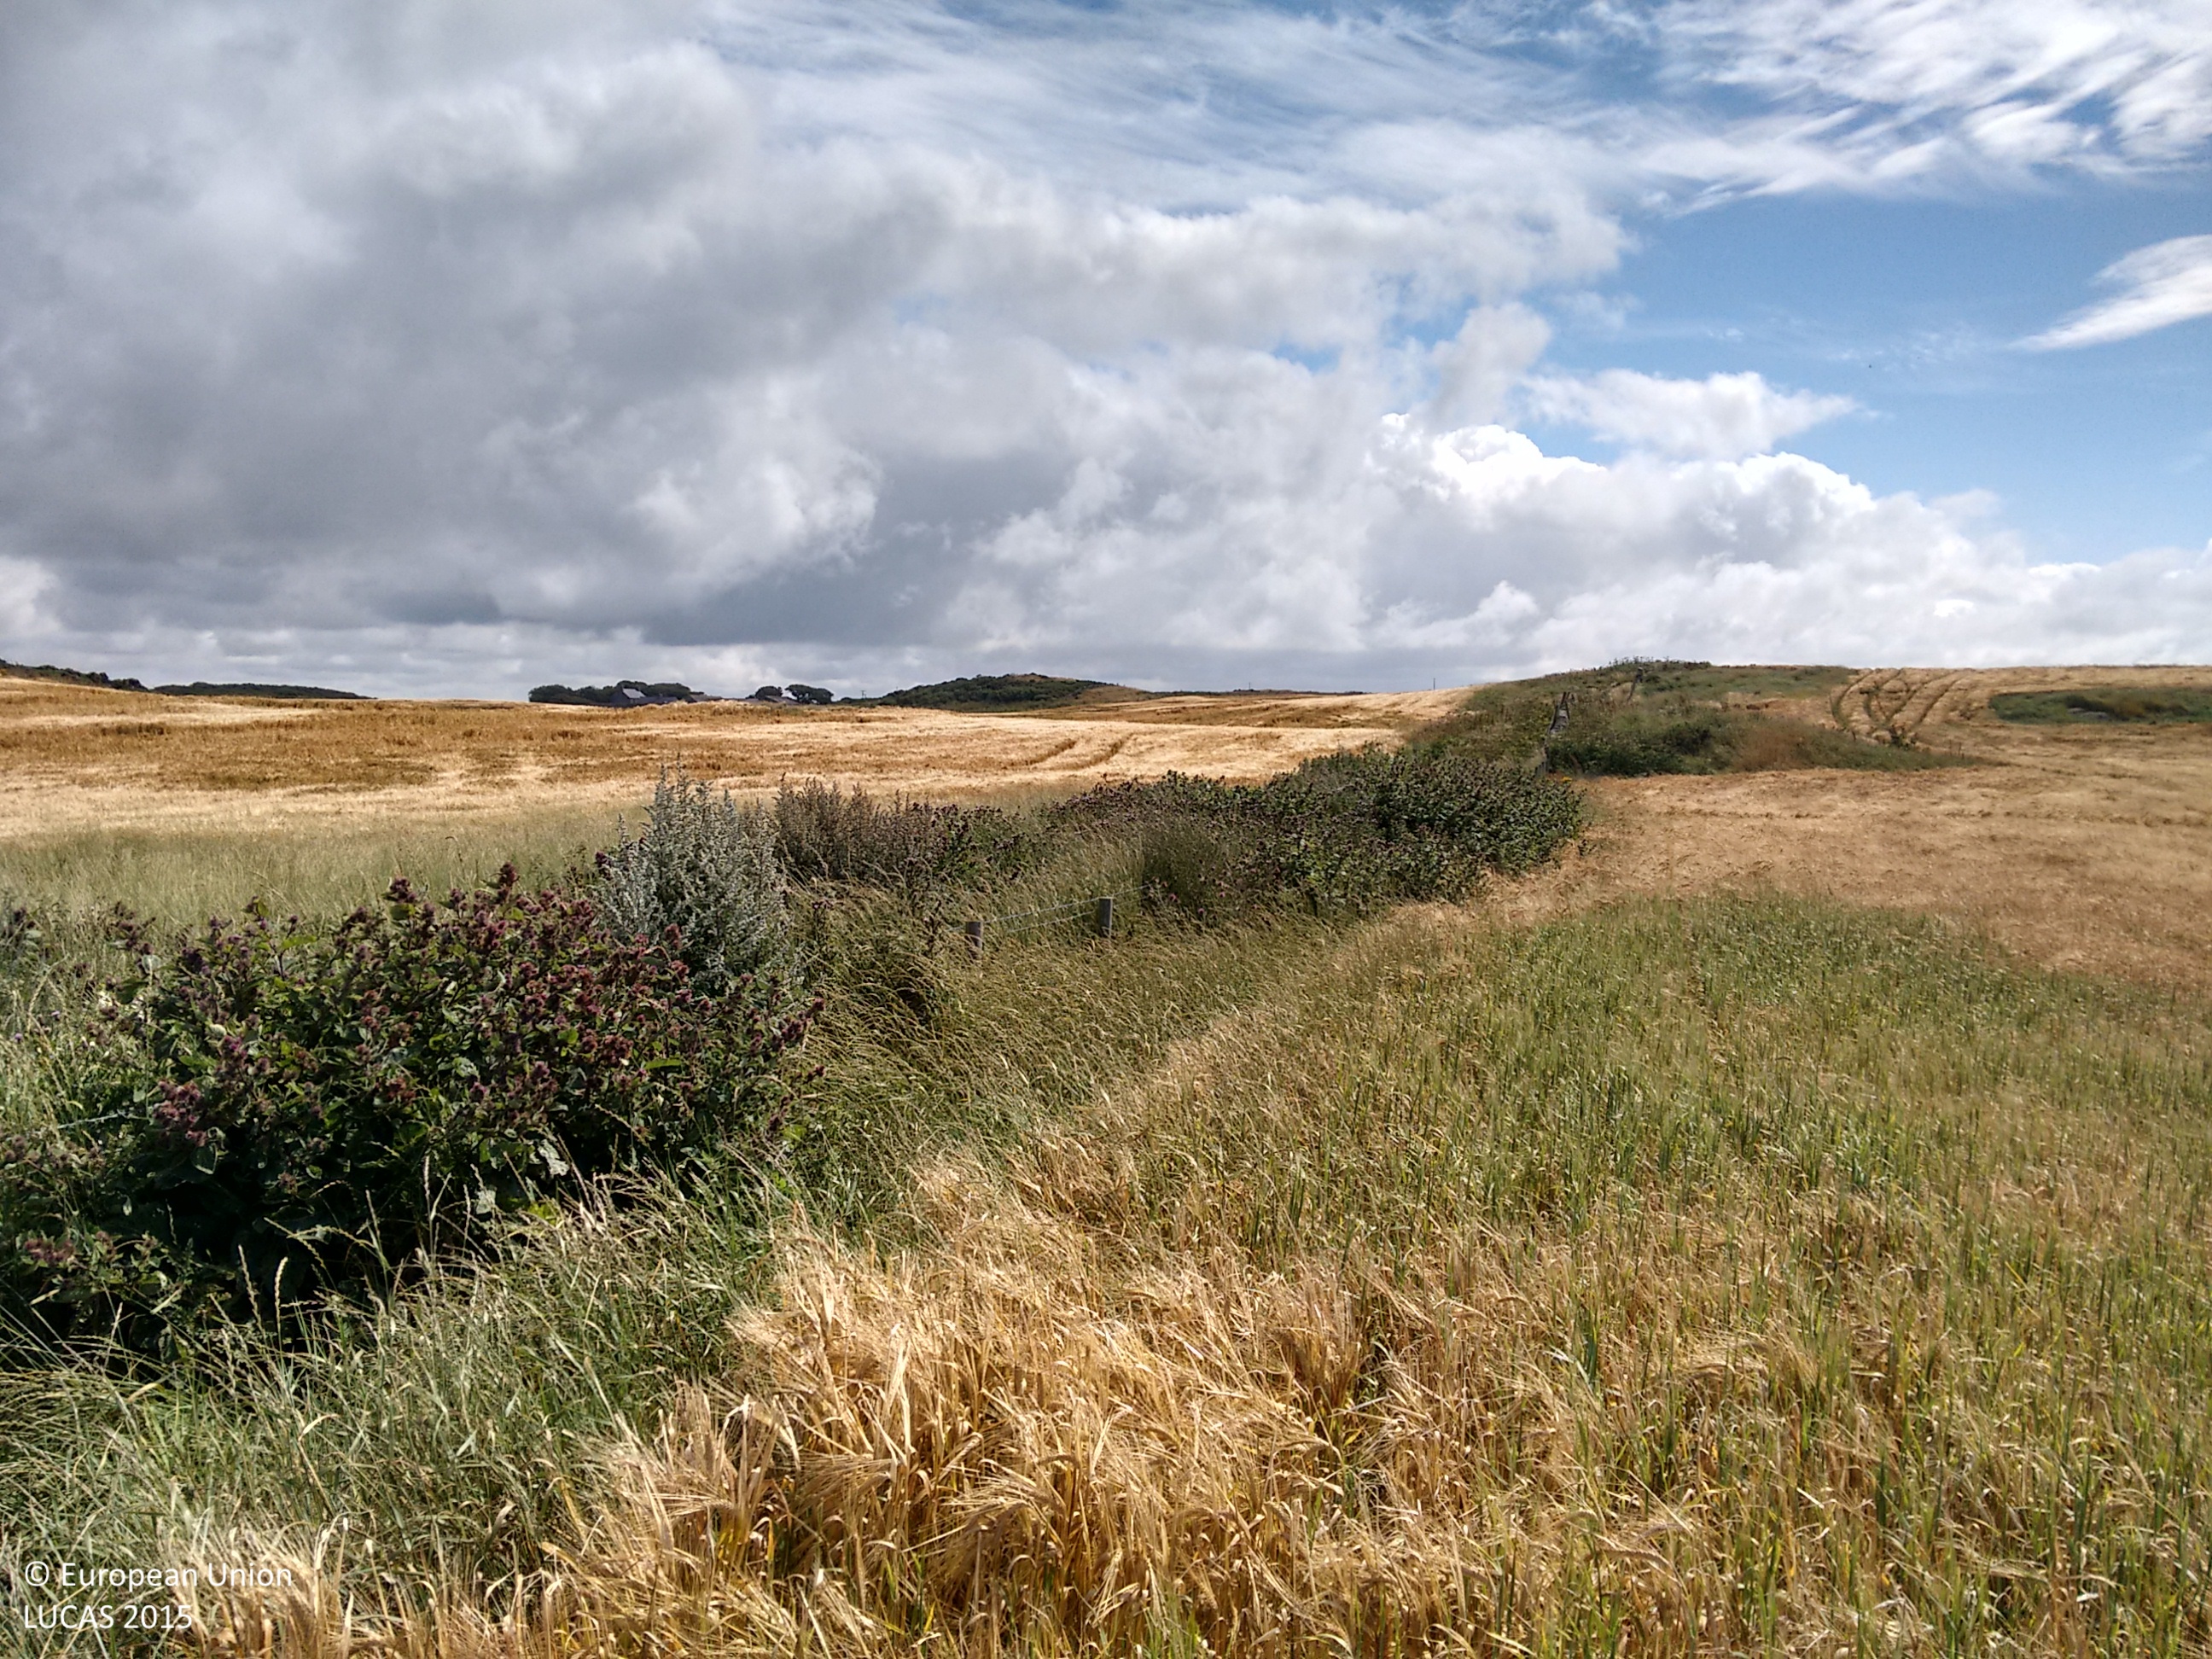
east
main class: Cropland
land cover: Barley
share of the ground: > 75 %
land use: Agriculture (excluding fallow land and kitchen gardens)
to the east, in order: Barley; Grass margins; Fences; Shruby margins; Barley
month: August
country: GB
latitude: 53.2179
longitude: -4.4970
